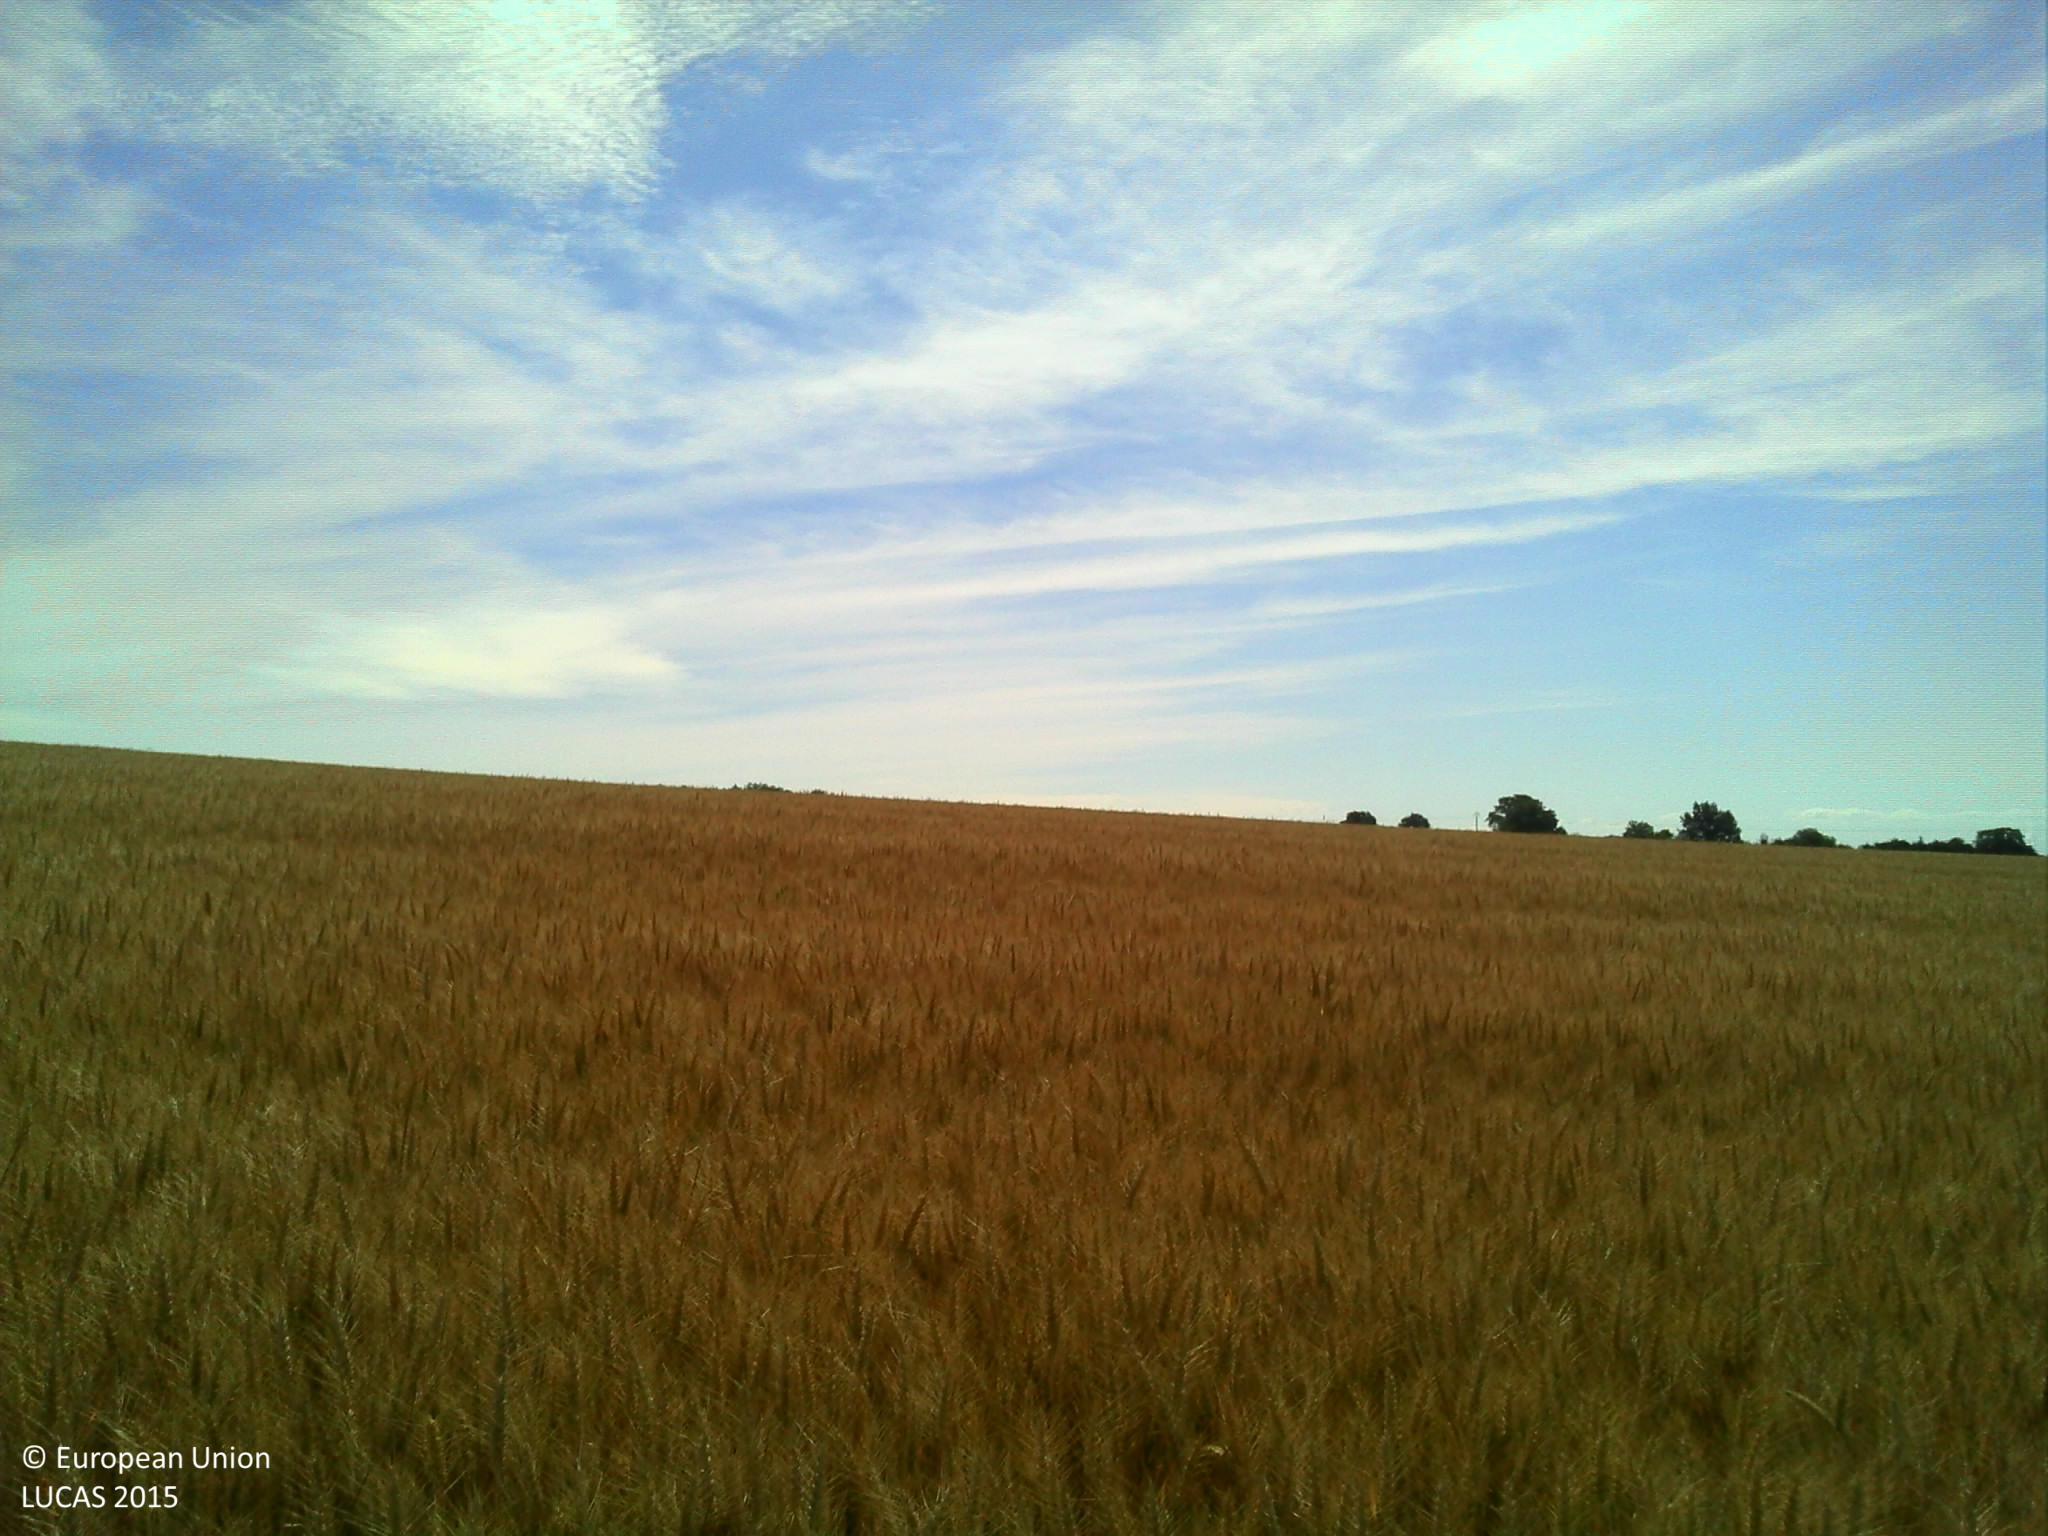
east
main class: Cropland
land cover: Common wheat
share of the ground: > 75 %
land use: Agriculture (excluding fallow land and kitchen gardens)
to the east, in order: Common wheat
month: June
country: FR
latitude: 46.2653
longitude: 3.2650
